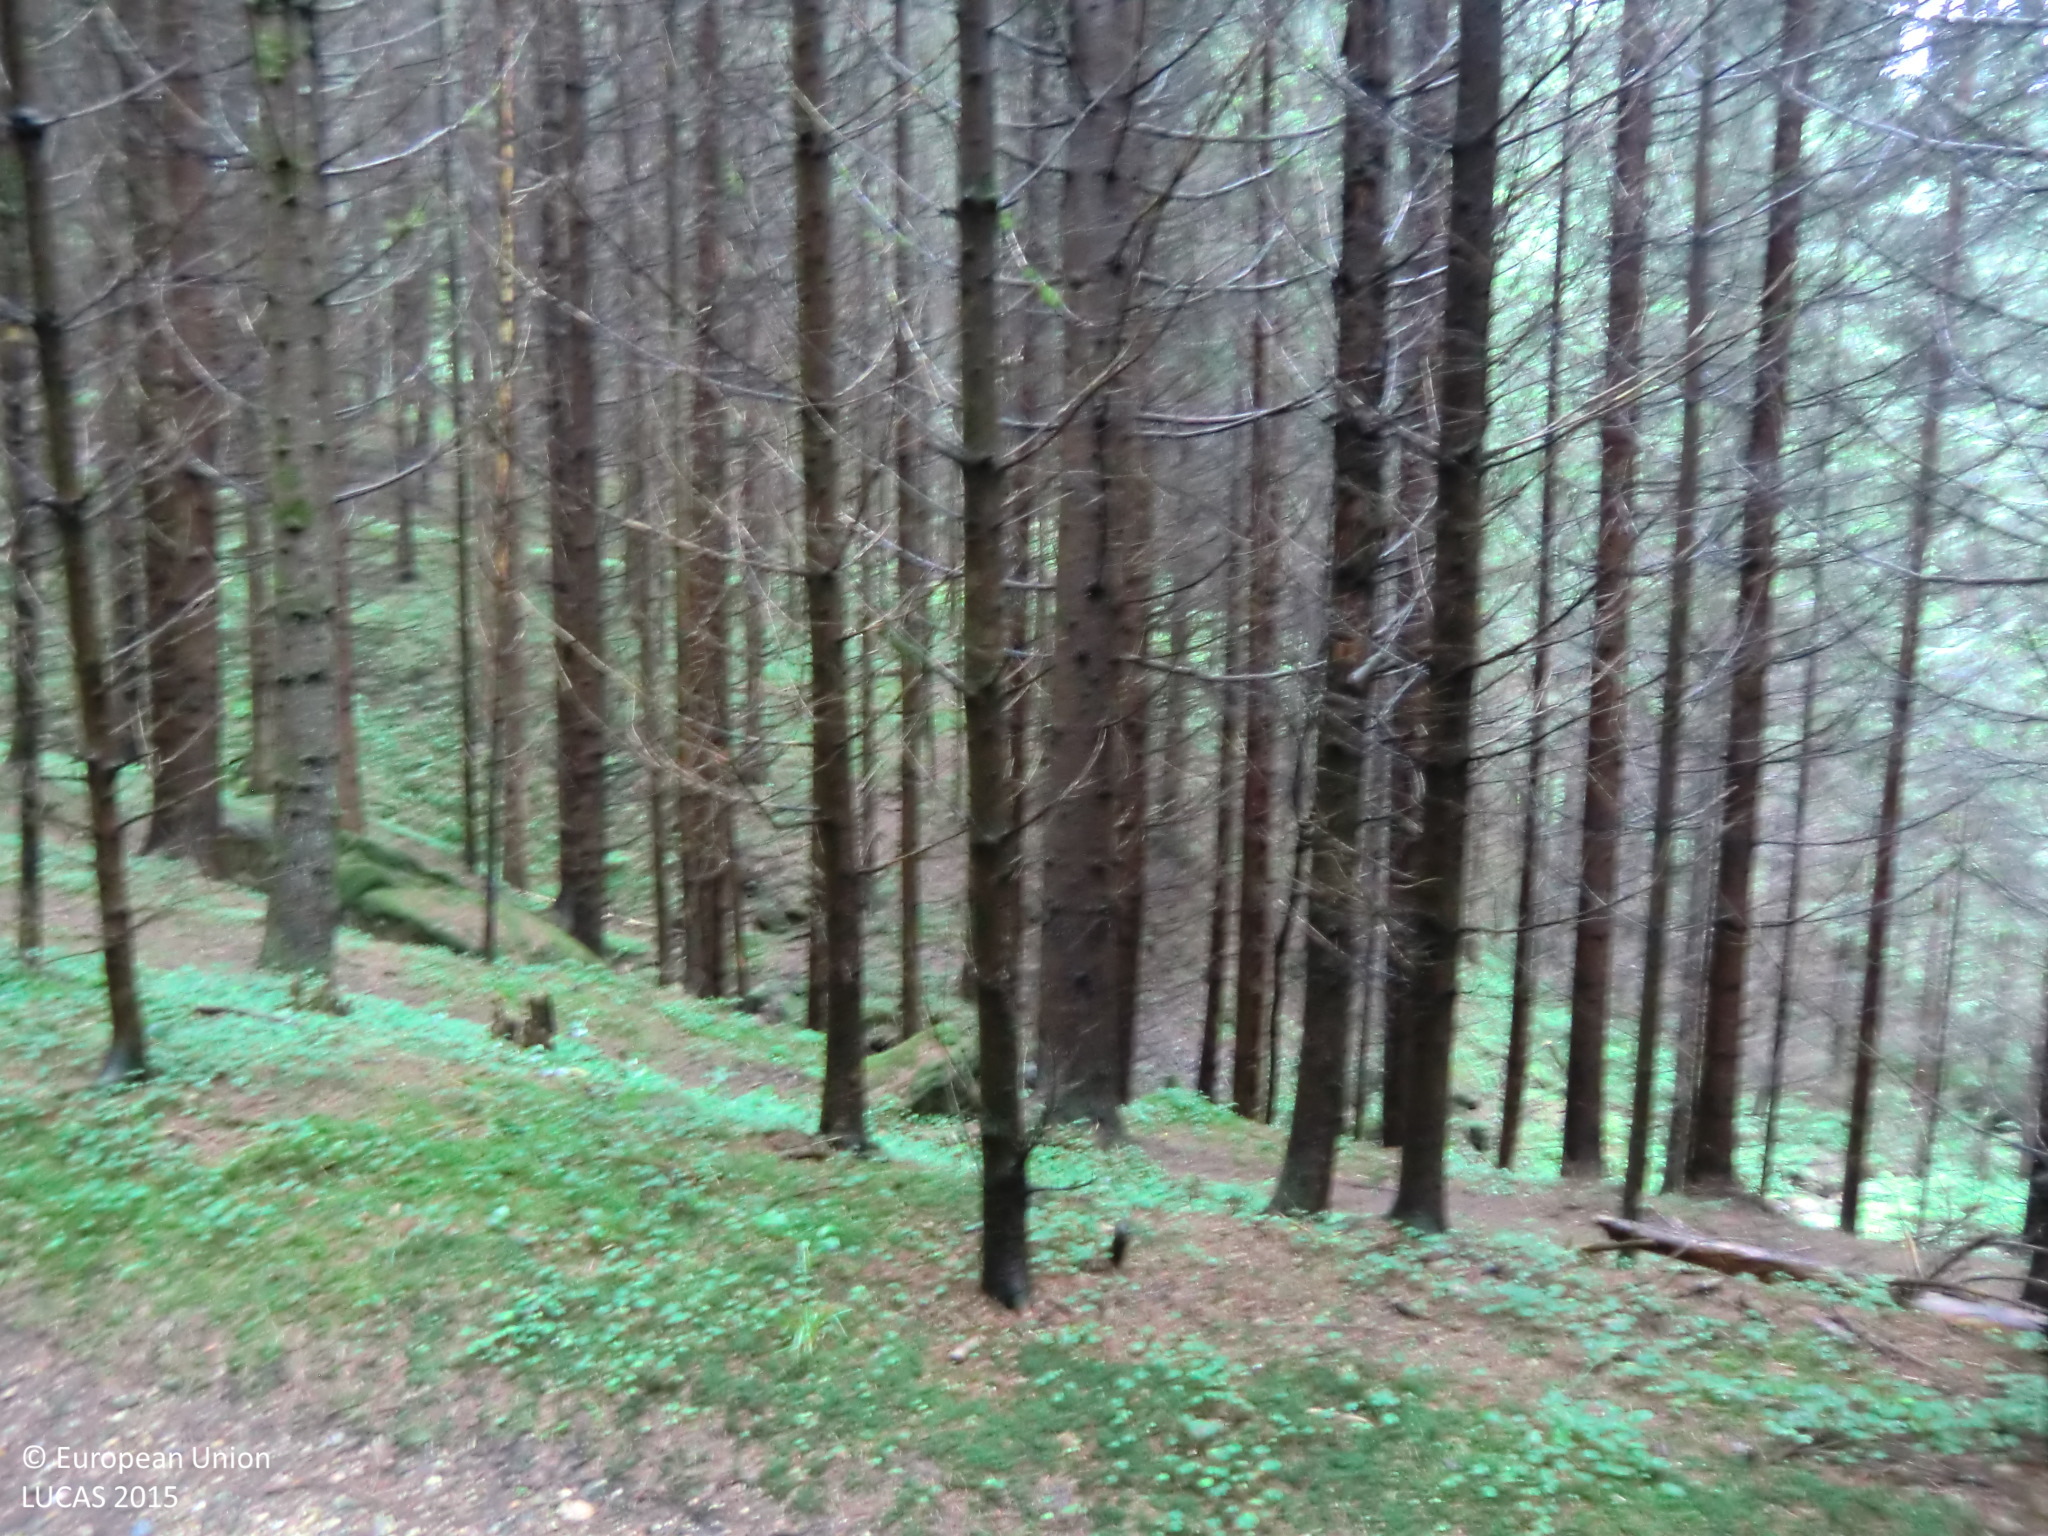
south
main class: Woodland
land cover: Spruce dominated coniferous woodland
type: hemiboreal forest and nemoral coniferous forest and mixed broadleaved-coniferous forest
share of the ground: > 75 %
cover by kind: coniferous forest trees 90 %, herbaceous plants 5 %, unconsolidated bare surface 5 %
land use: Forestry
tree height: > 5 m
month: June
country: AT
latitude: 48.5300
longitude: 14.4559
